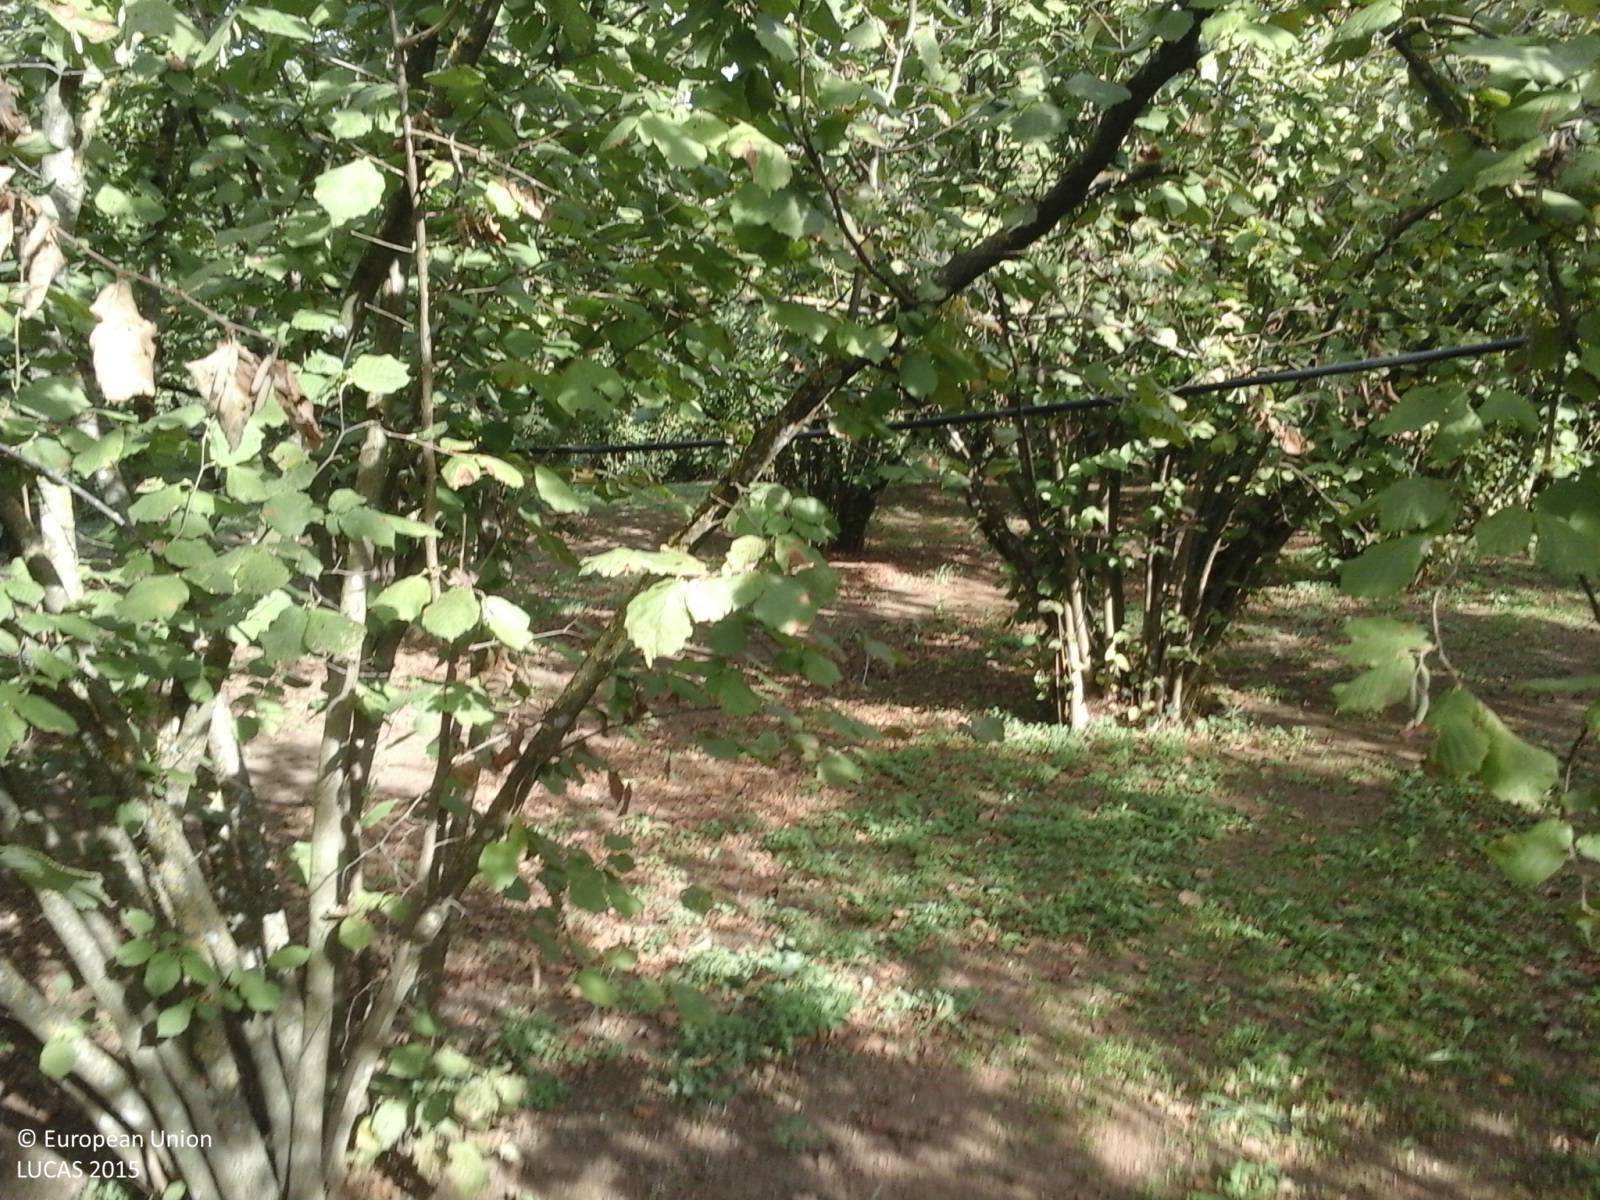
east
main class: Cropland
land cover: Nuts trees
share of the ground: > 75 %
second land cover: Other bare soil
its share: > 75 %
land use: Agriculture (excluding fallow land and kitchen gardens)
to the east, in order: Nuts trees; Other bare soil; Ditches and canals; Nuts trees; Abandoned hedges; Ditches and canals; Electric lines; Tracks; Other bare soil; Vineyards
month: September
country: IT
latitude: 42.3555
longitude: 12.3593
